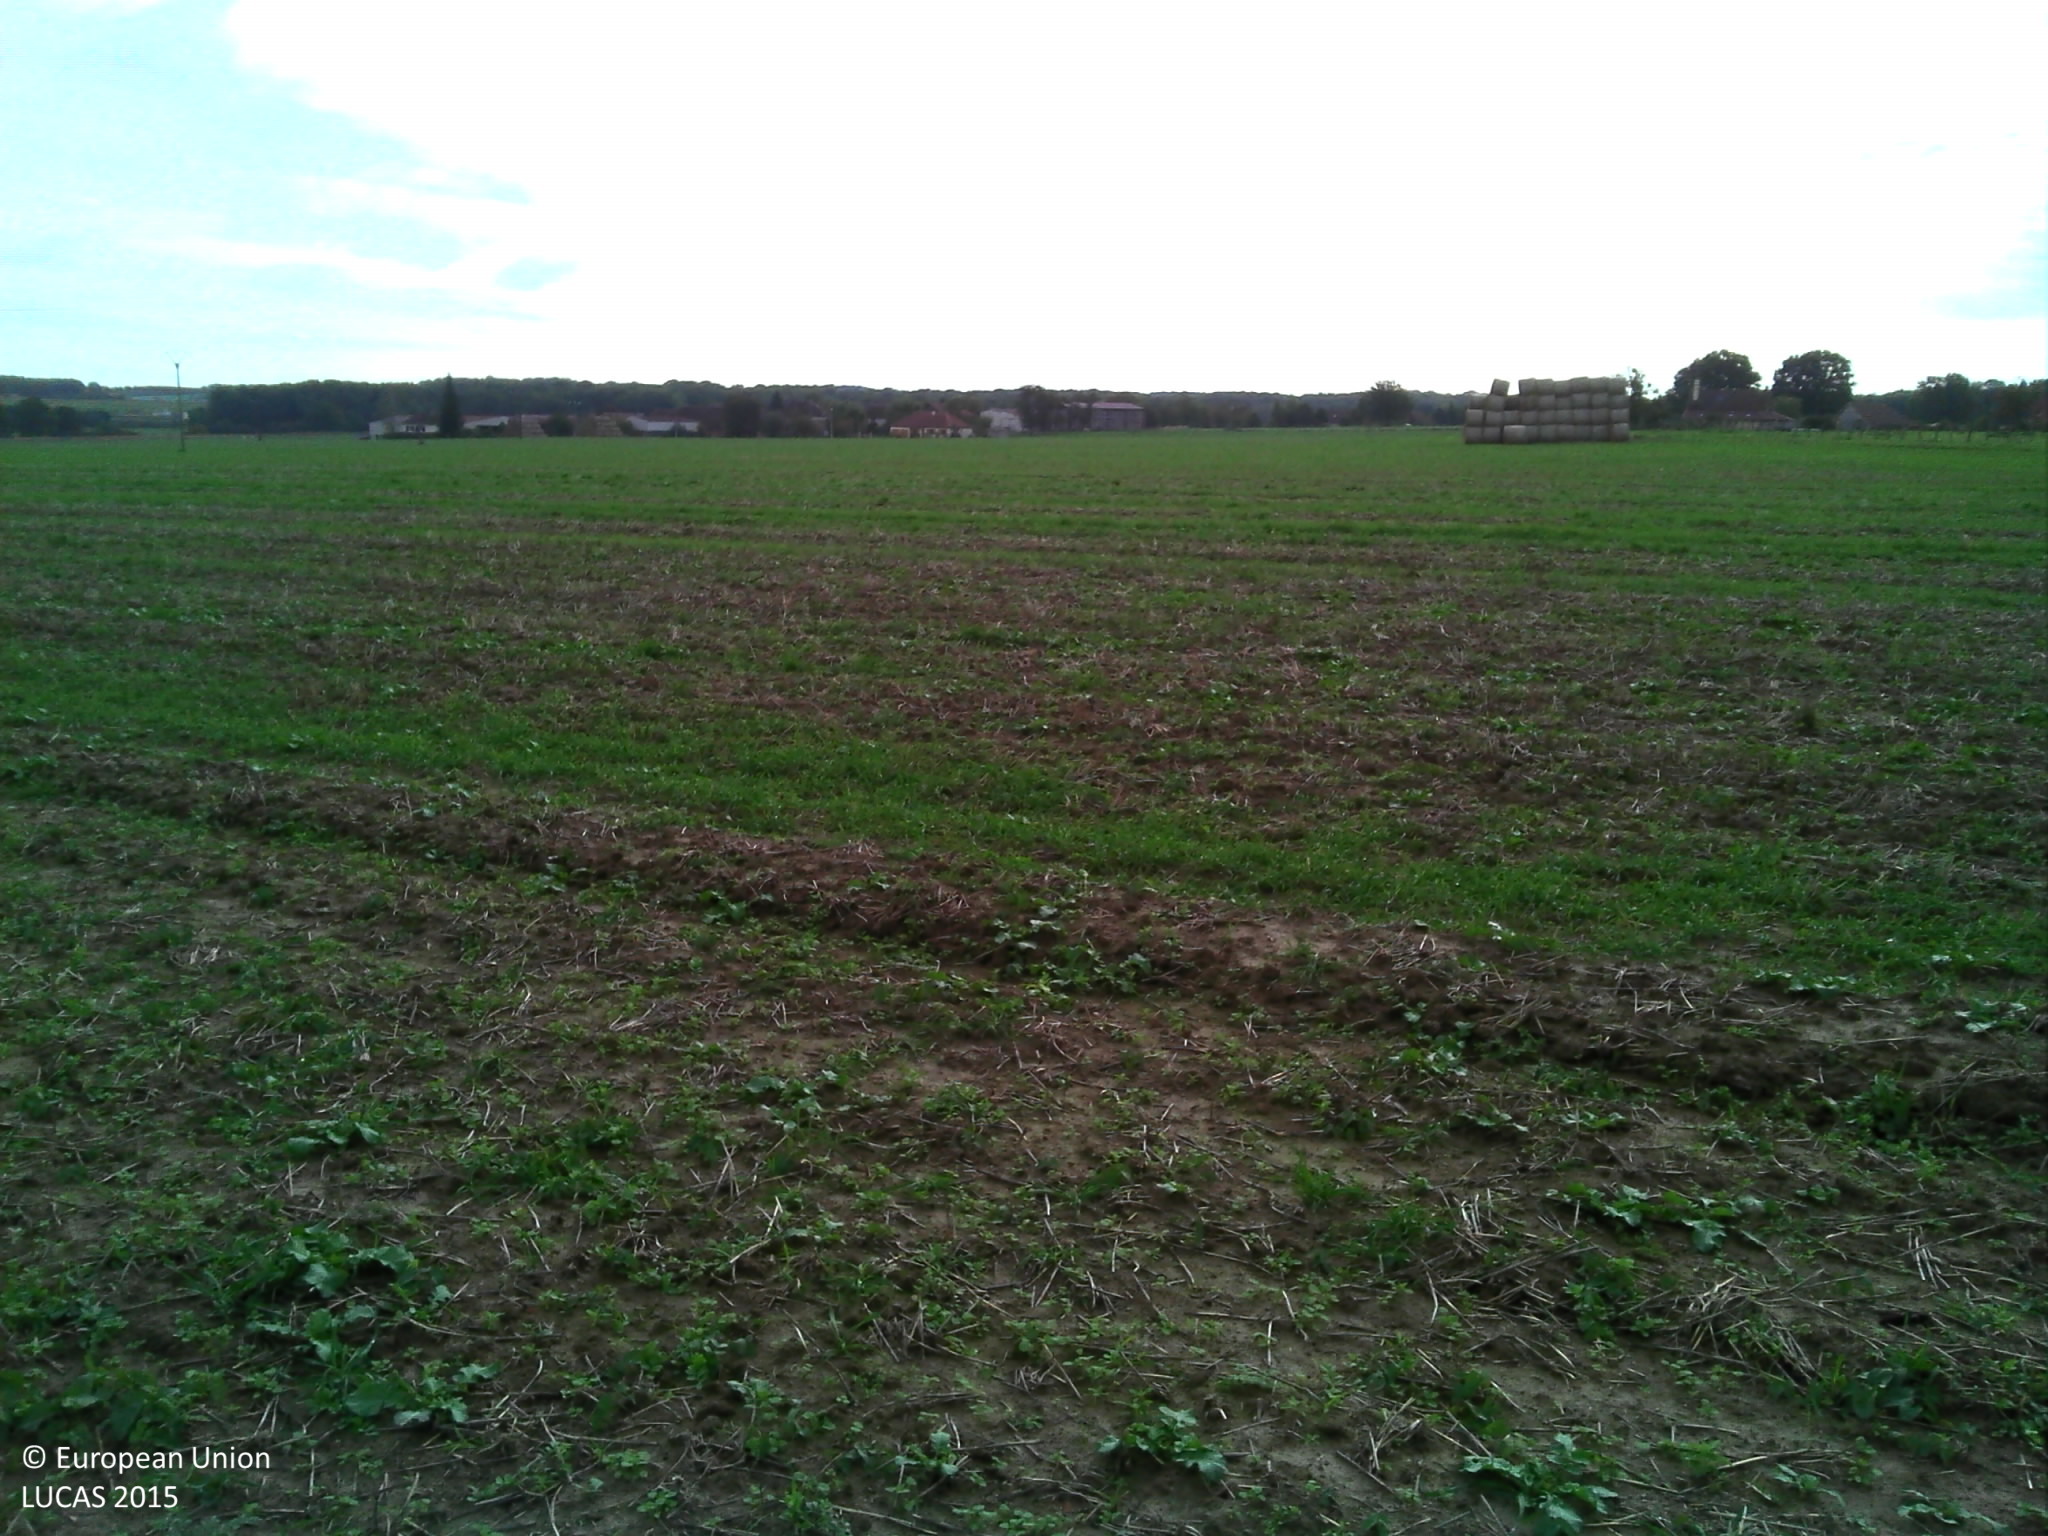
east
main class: Grassland
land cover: Spontaneously vegetated surfaces
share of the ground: 50 - 75 %
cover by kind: herbaceous plants 80 %, unconsolidated bare surface 20 %
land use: Agriculture (excluding fallow land and kitchen gardens)
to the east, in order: Spontaneously vegetated surfaces; Electric lines; Spontaneously vegetated surfaces; Electric lines; Spontaneously vegetated surfaces
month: October
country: FR
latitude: 48.2178
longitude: 4.2499
